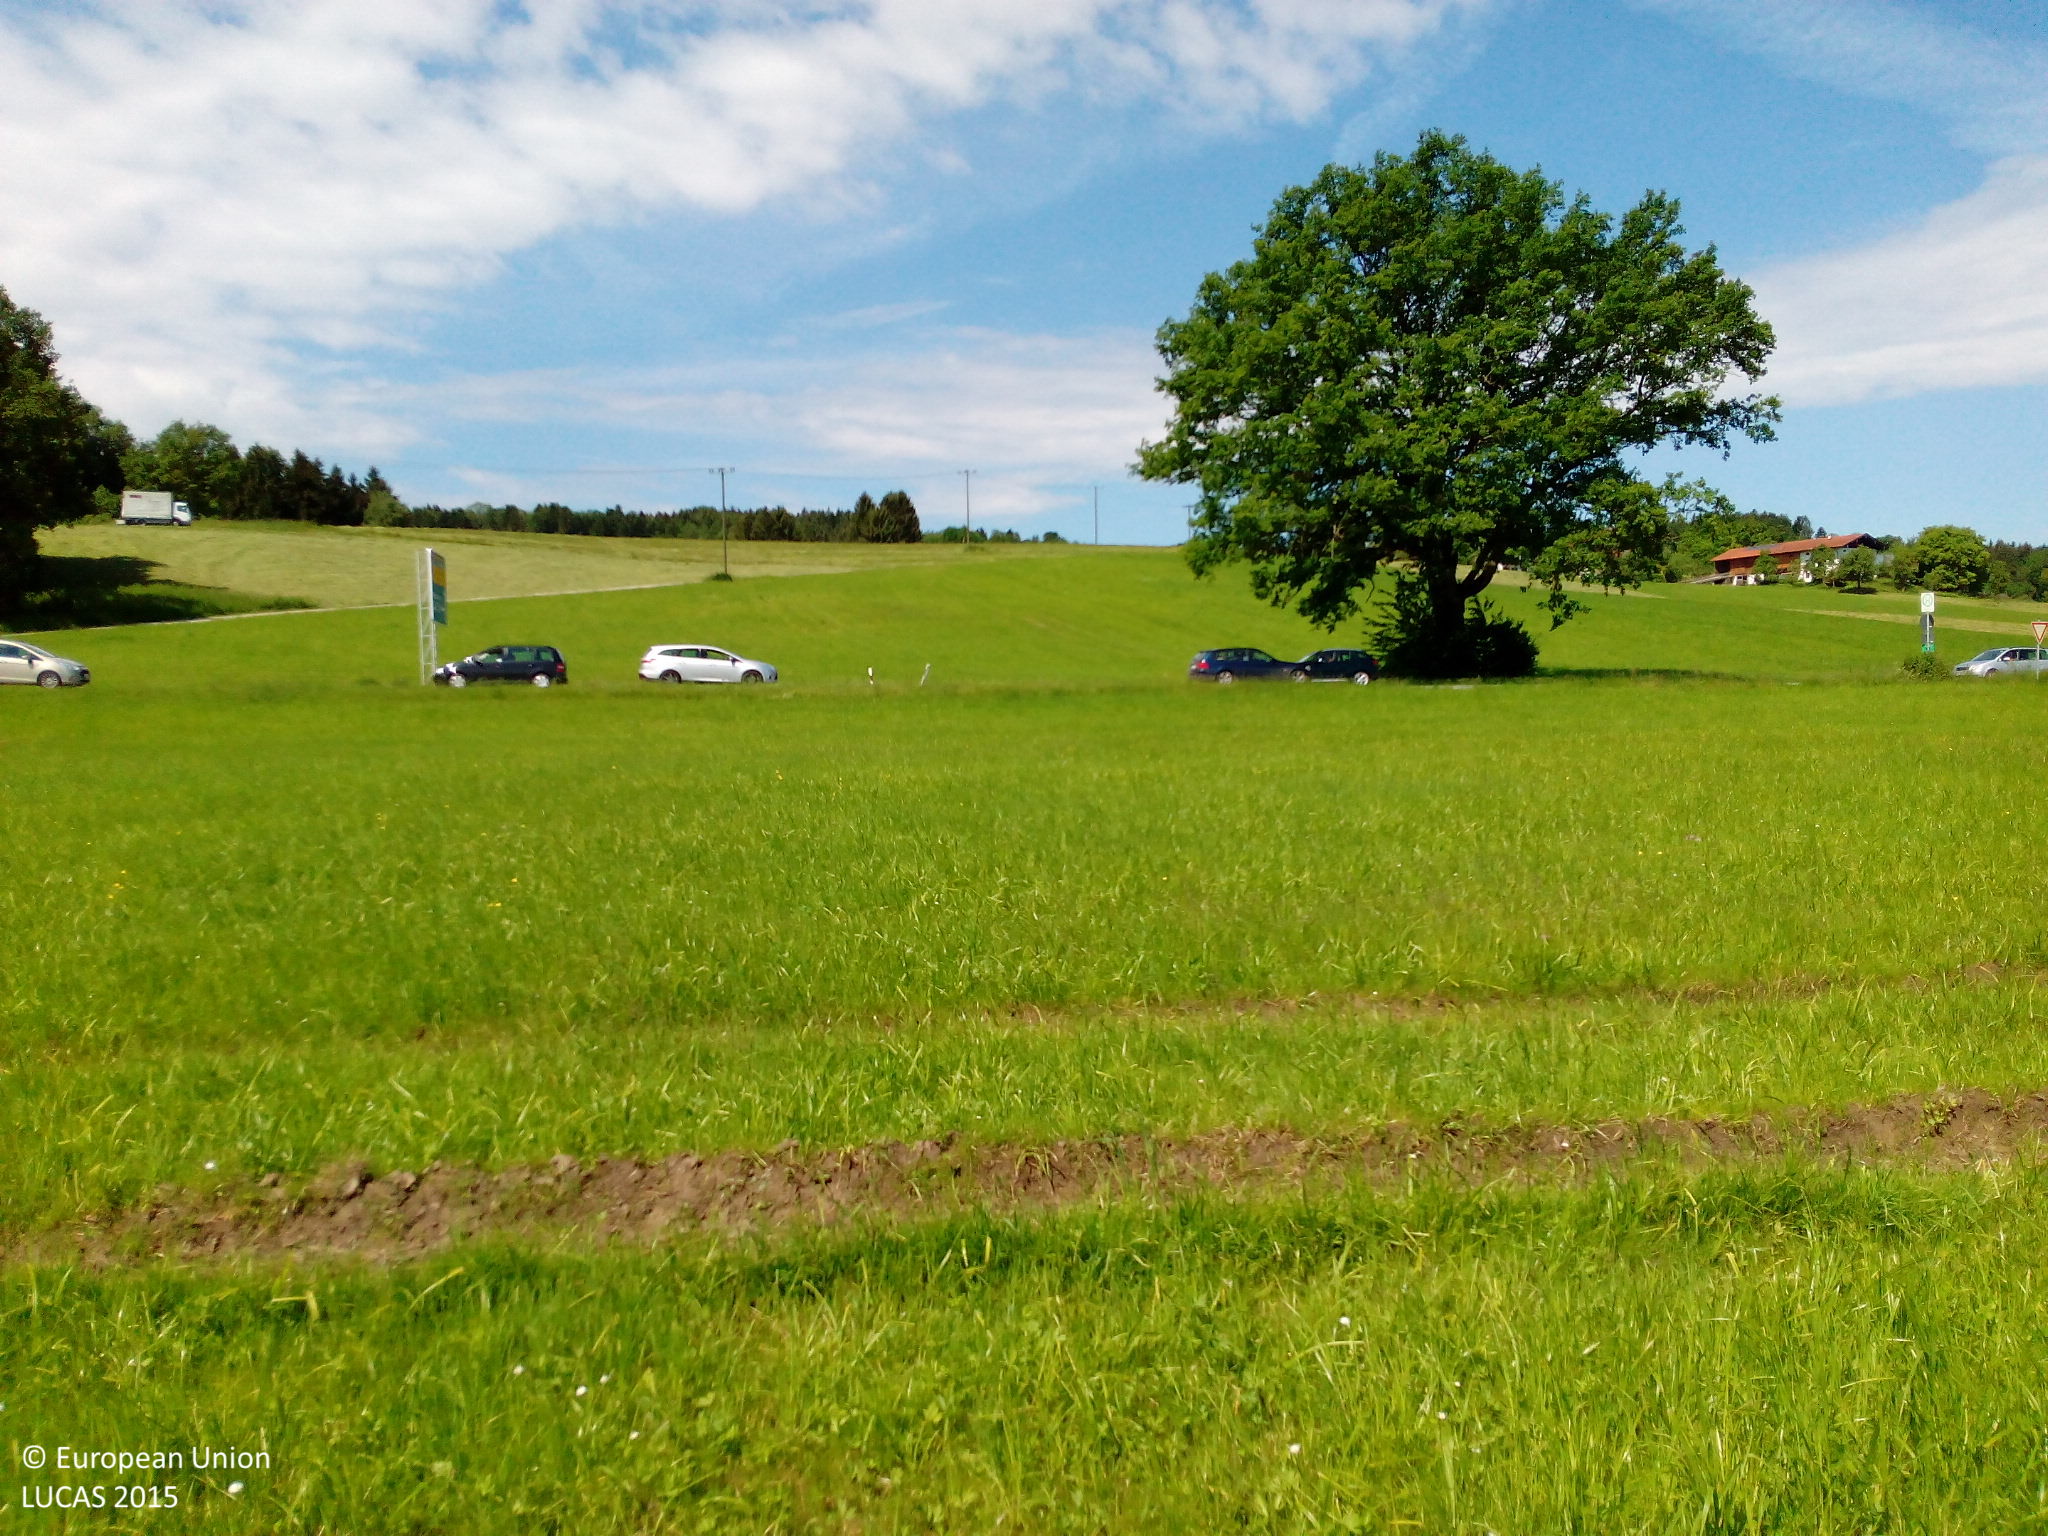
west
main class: Grassland
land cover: Grassland without tree/shrub cover
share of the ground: > 75 %
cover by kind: herbaceous plants 100 %
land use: Agriculture (excluding fallow land and kitchen gardens)
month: June
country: DE
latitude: 47.8202
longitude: 12.3627
